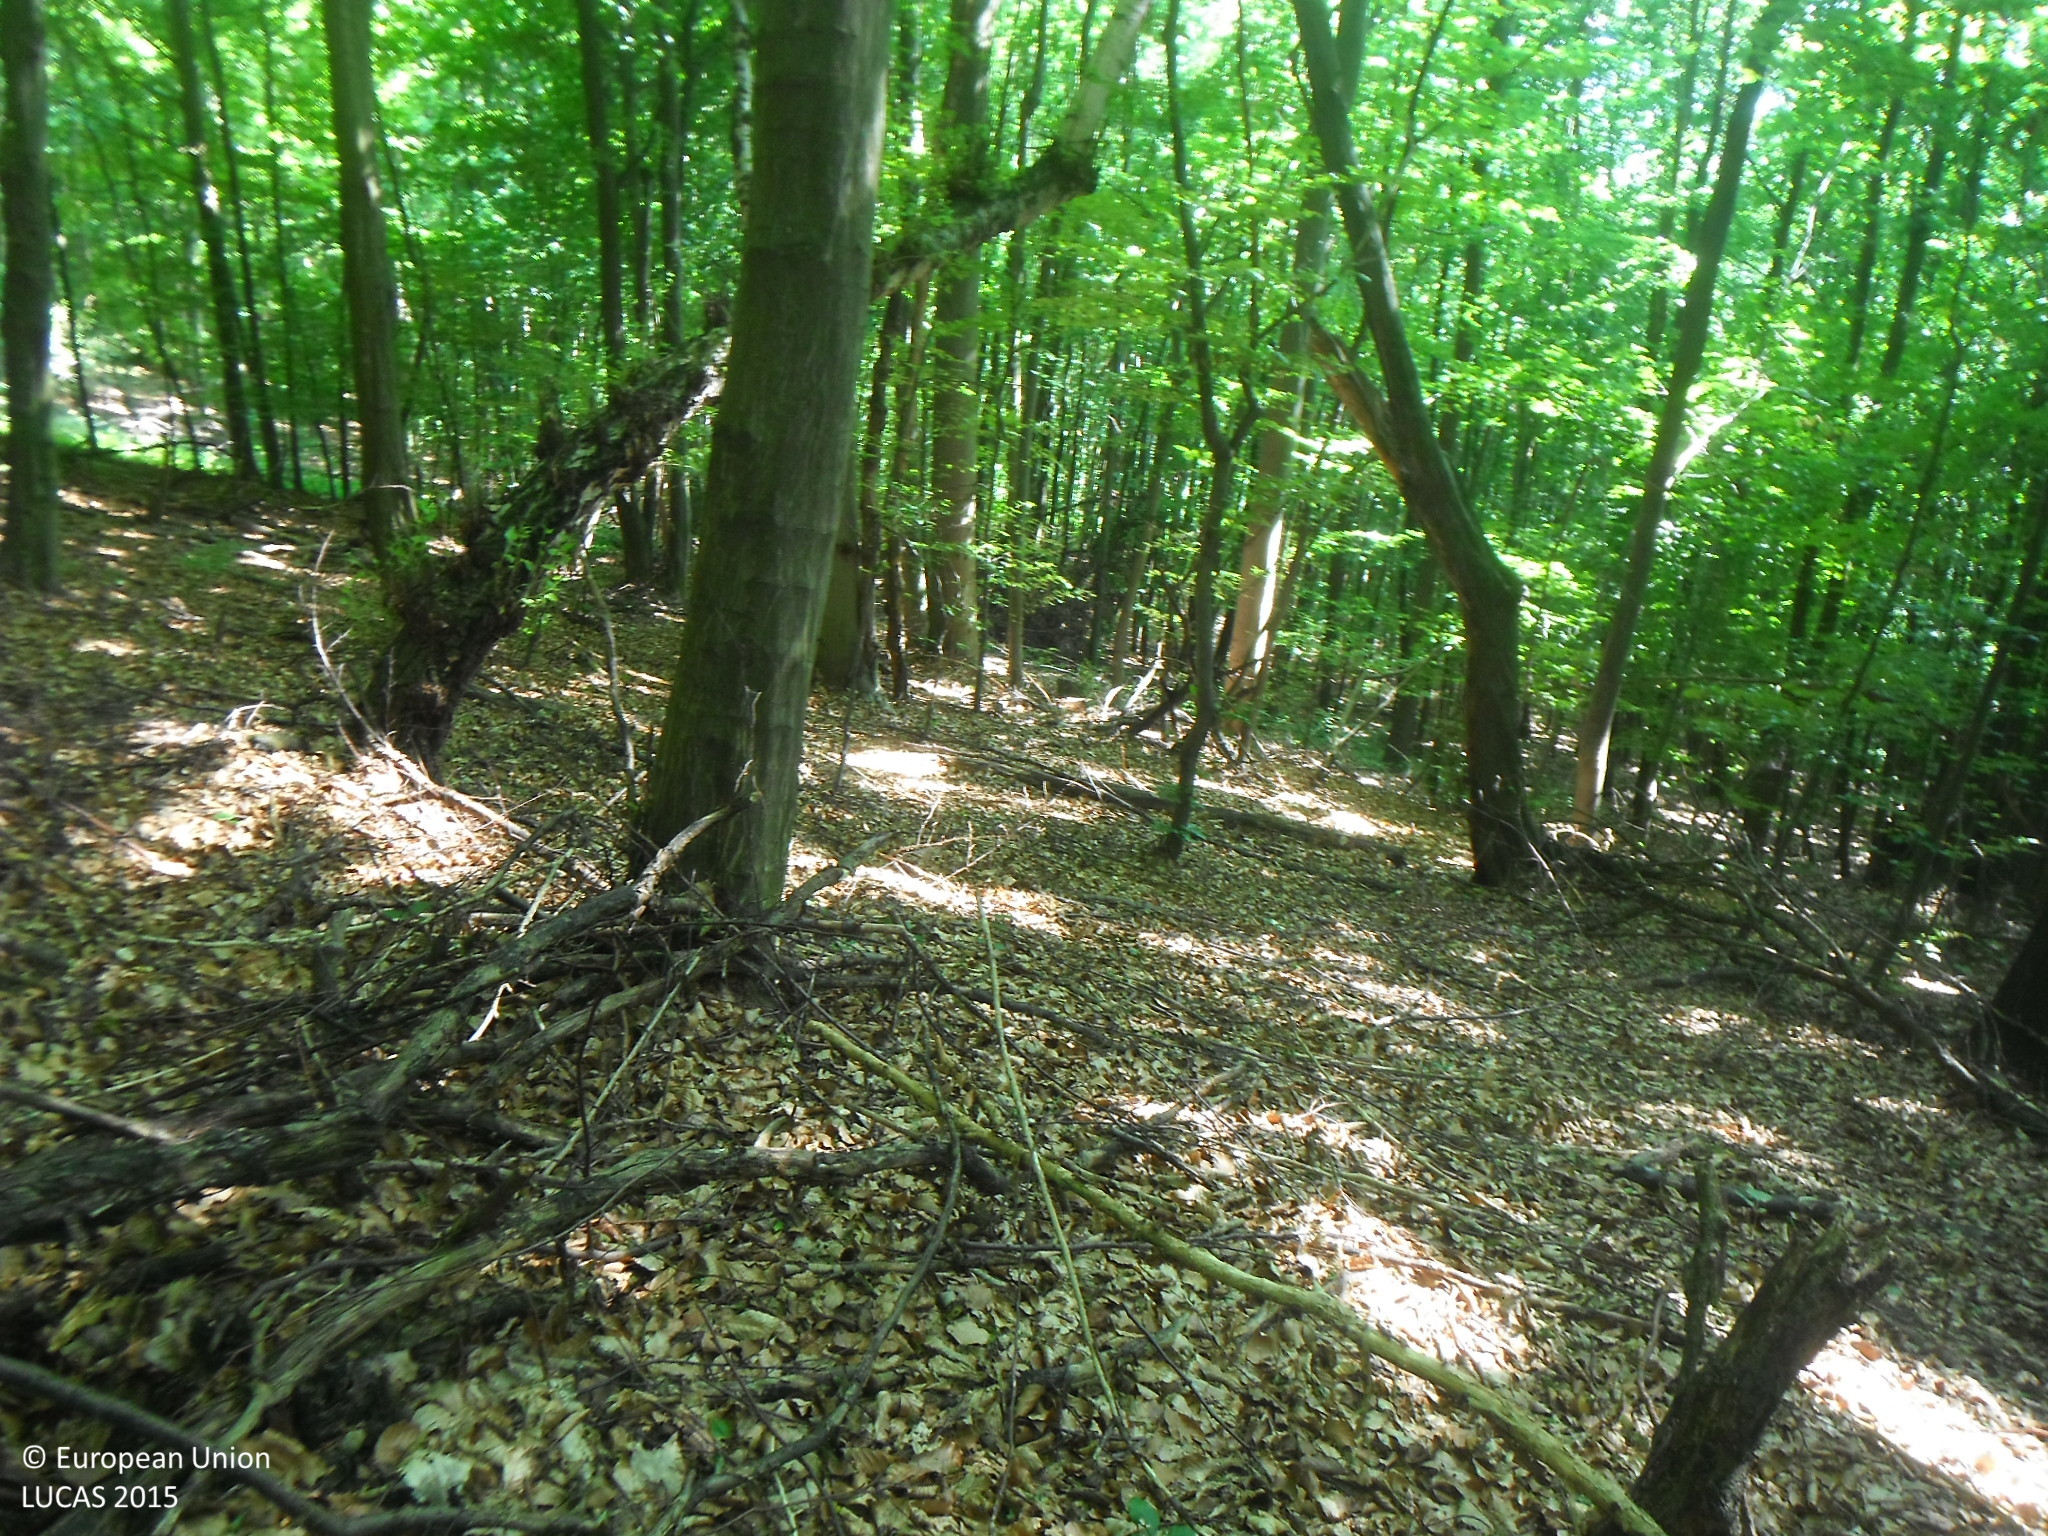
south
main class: Woodland
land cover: Broadleaved woodland
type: beech forest
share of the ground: > 75 %
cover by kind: broadleaved forest trees 100 %
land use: Forestry
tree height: > 5 m
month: June
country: SK
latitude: 49.0670
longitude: 21.5604
